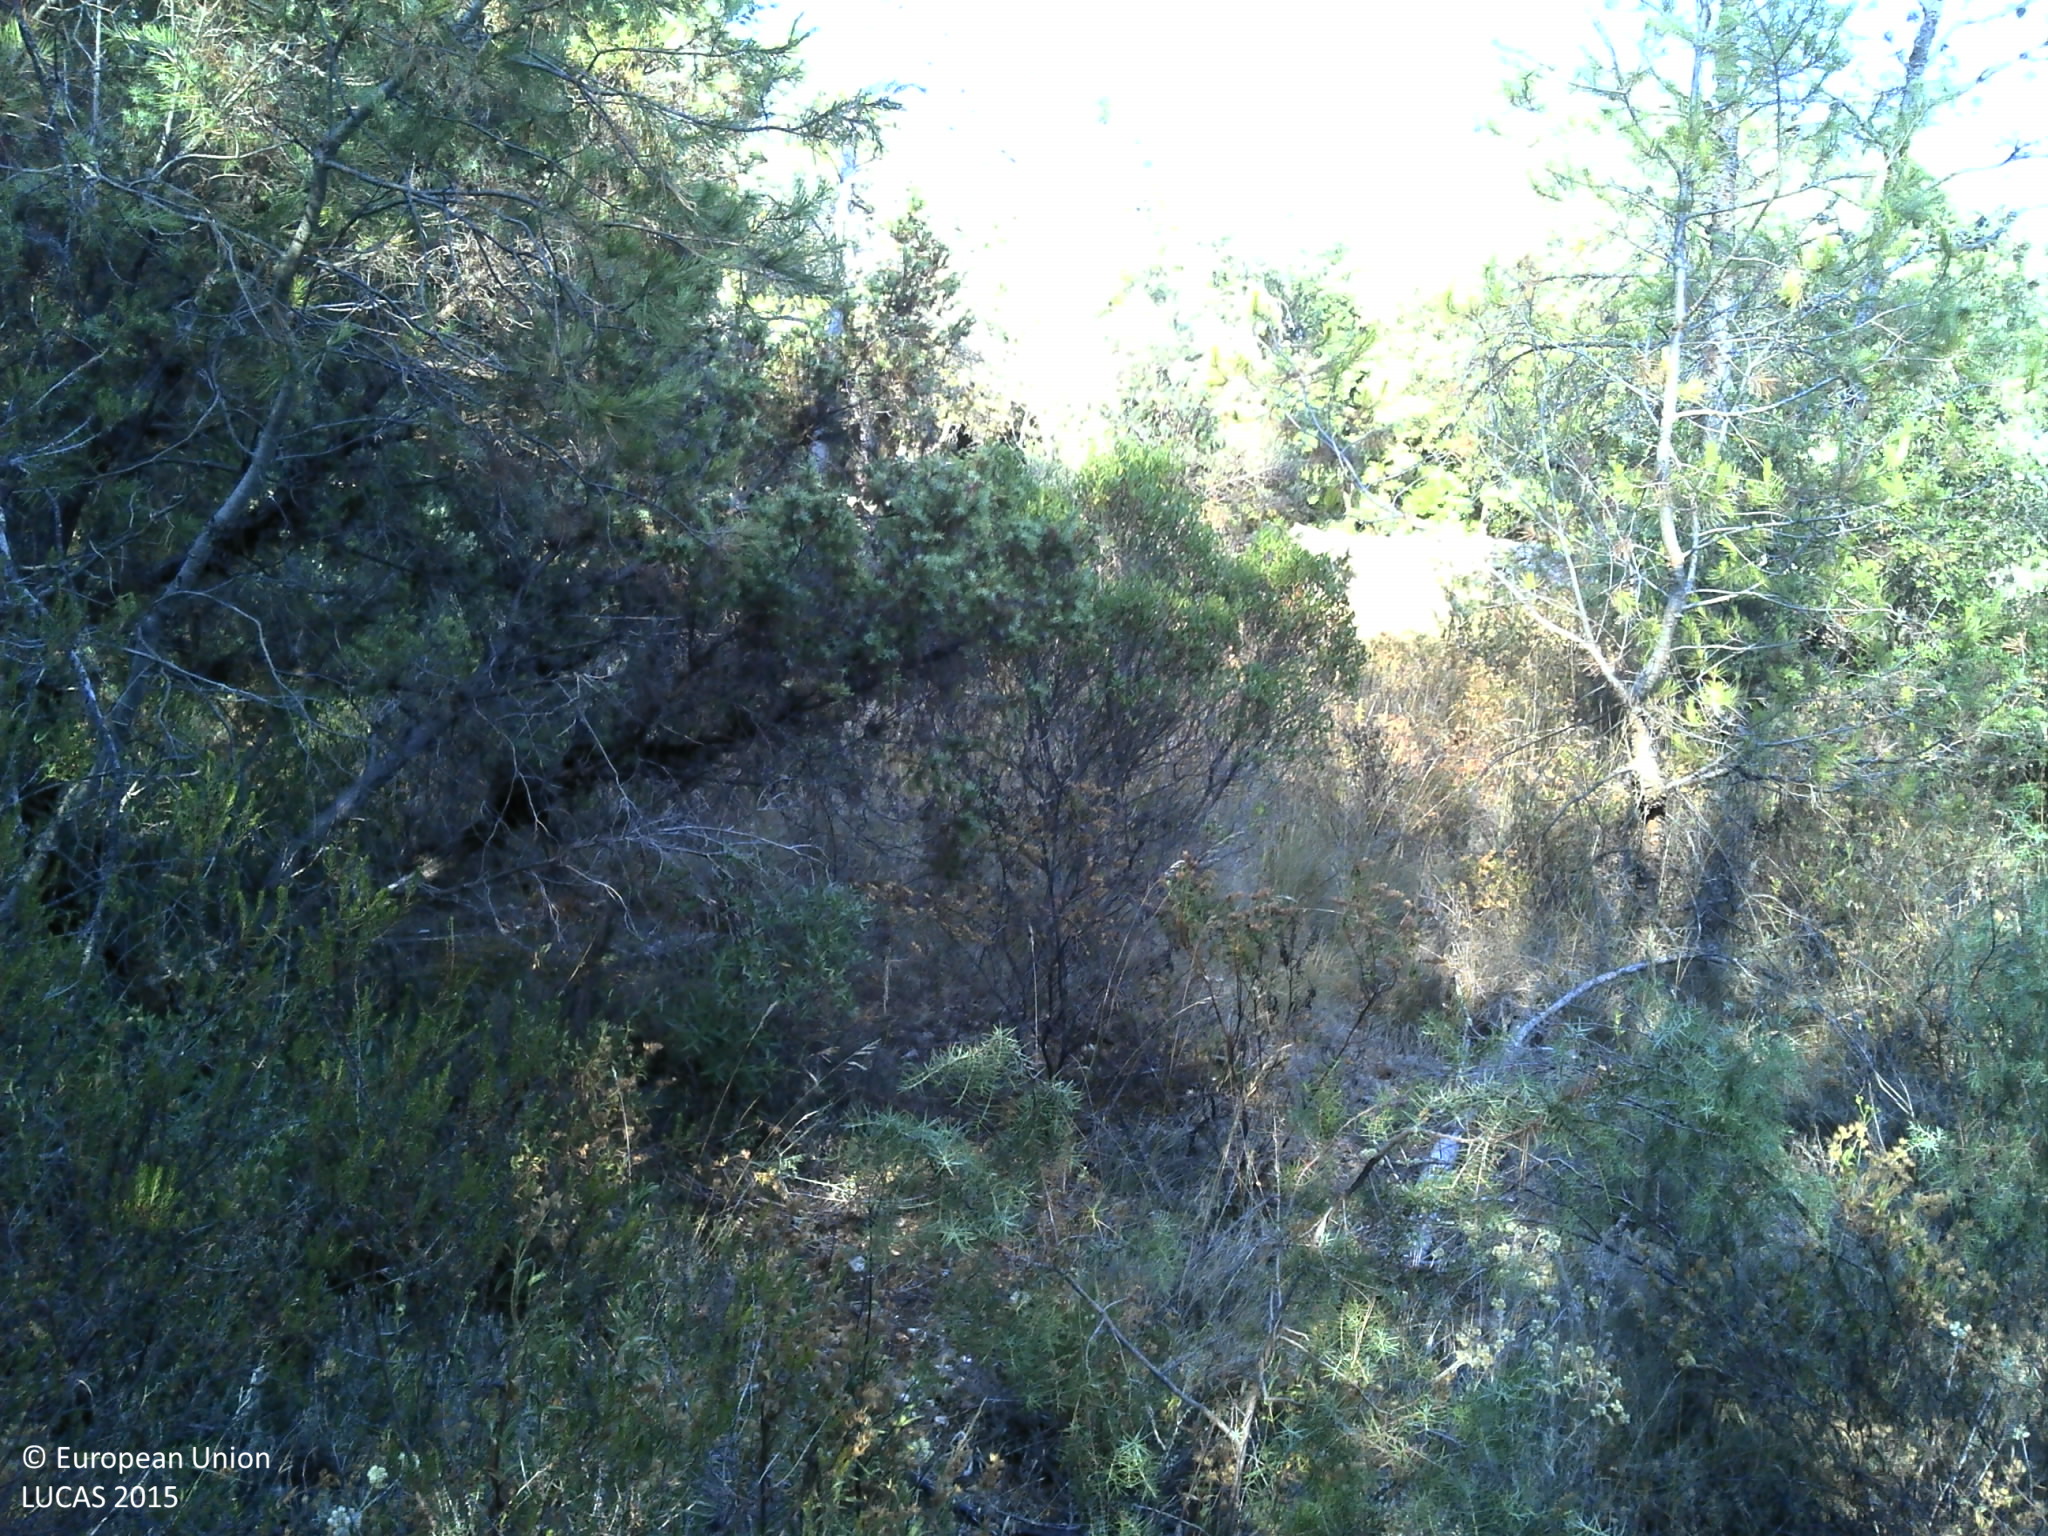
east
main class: Woodland
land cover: Other mixed woodland
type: broadleaved evergreen forest
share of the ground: > 75 %
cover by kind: broadleaved forest trees 35 %, herbaceous plants 30 %, coniferous forest trees 25 %, unconsolidated bare surface 10 %
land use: Forestry
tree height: < 5 m
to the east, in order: Other mixed woodland; Tracks; Other mixed woodland
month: July
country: FR
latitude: 43.6838
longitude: 3.6199
